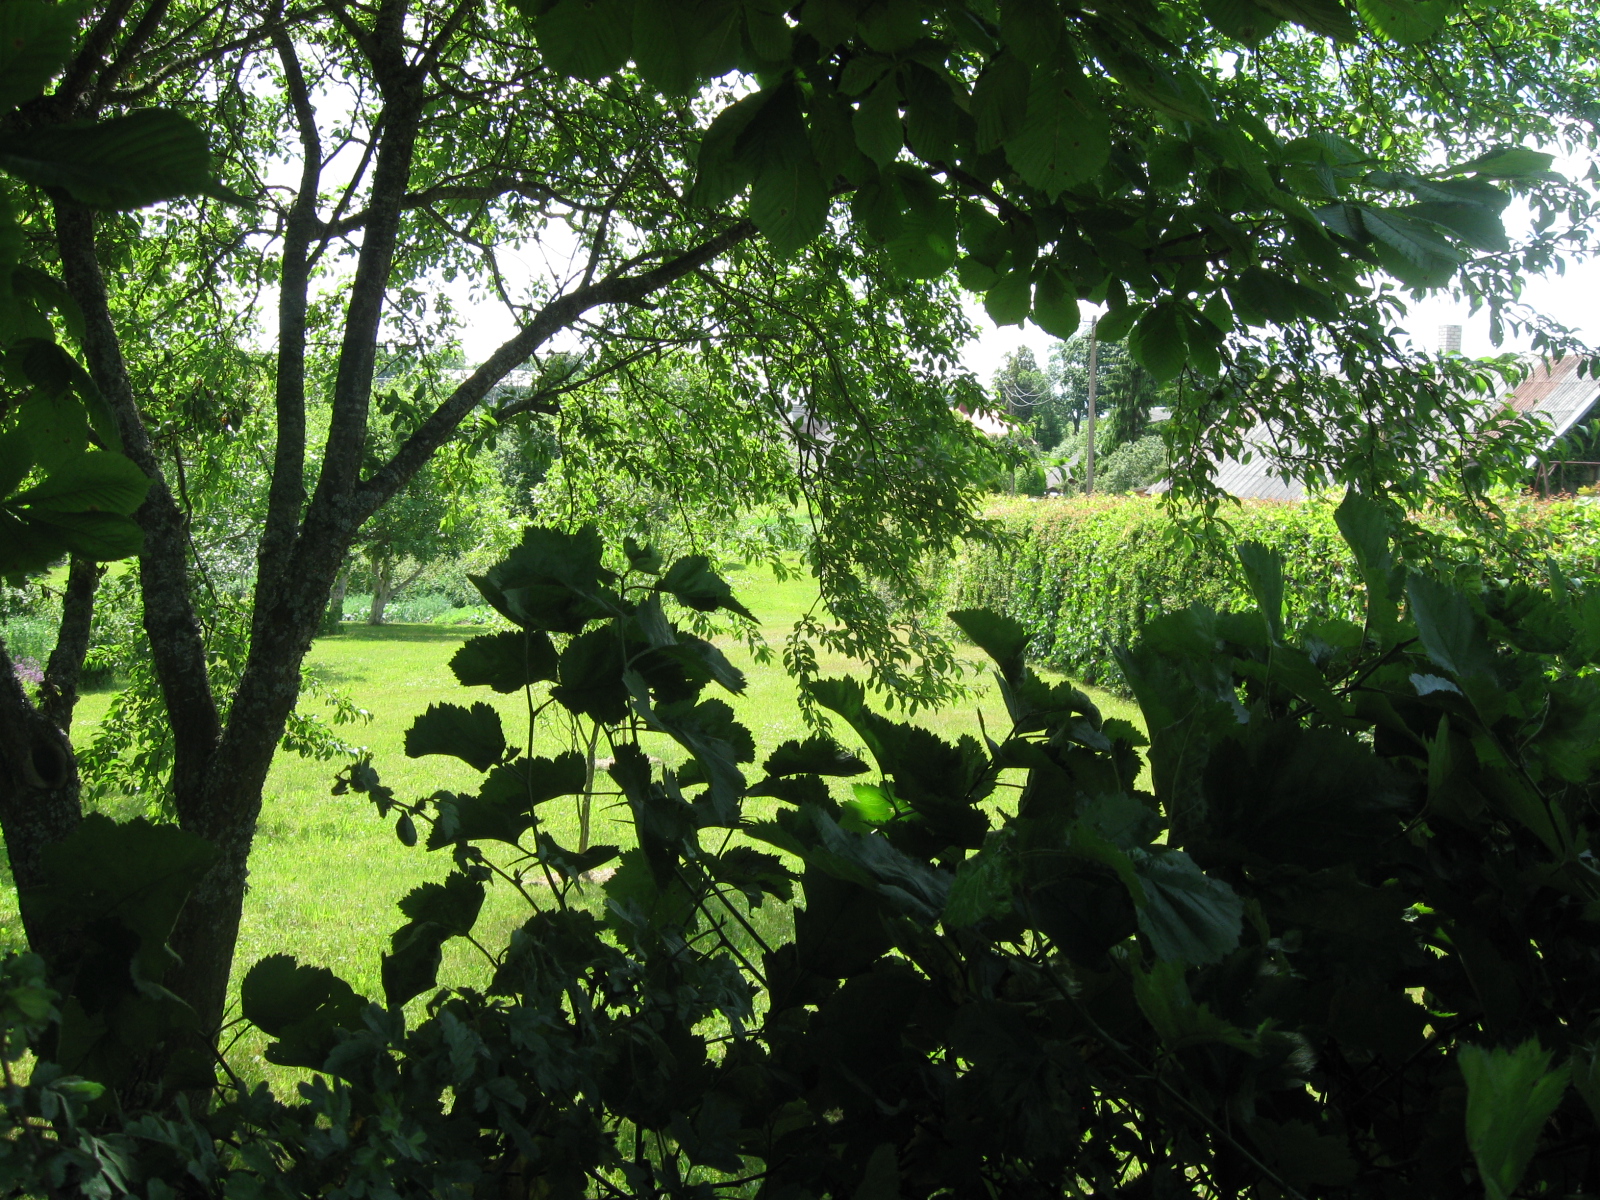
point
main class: Grassland
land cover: Grassland without tree/shrub cover
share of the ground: > 75 %
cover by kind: herbaceous plants 100 %
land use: Residential
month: June
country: LT
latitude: 54.4860
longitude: 24.5999
